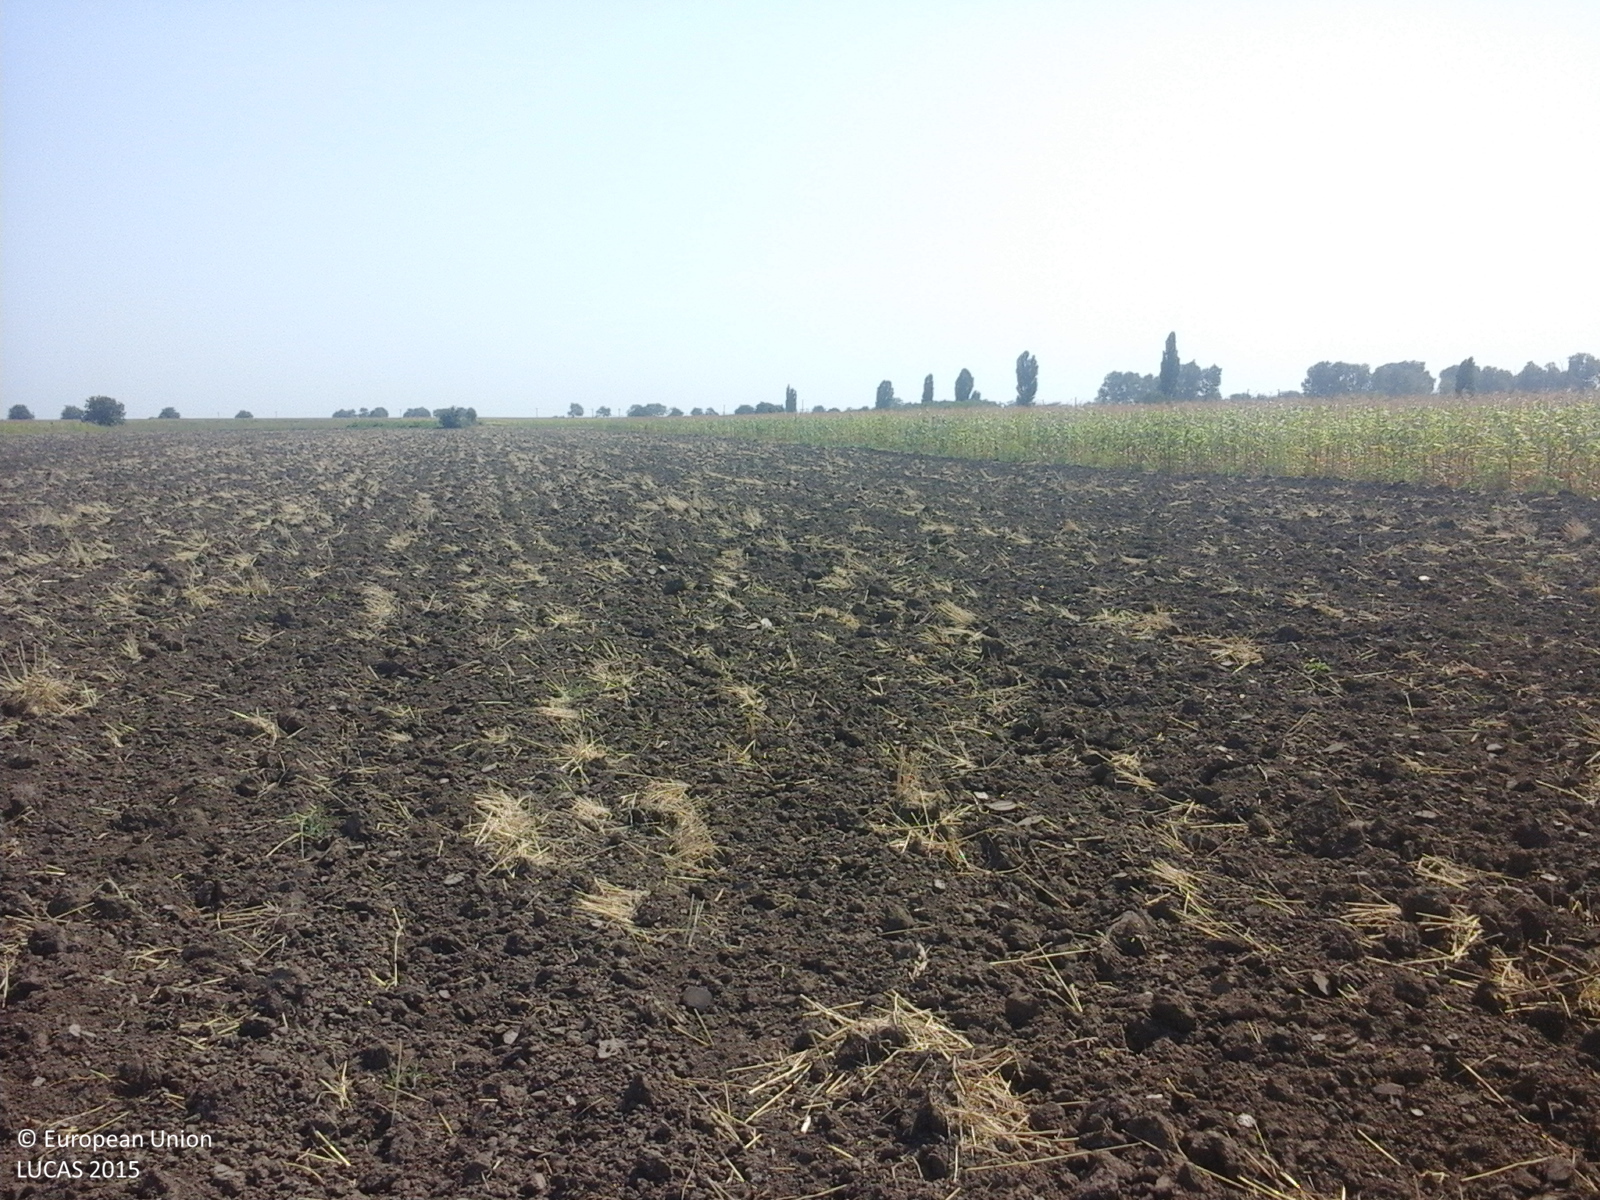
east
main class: Cropland
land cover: Common wheat
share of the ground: < 10 %
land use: Agriculture (excluding fallow land and kitchen gardens)
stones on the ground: < 10 %
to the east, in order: Common wheat; Maize
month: August
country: RO
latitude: 45.0917
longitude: 27.3098
